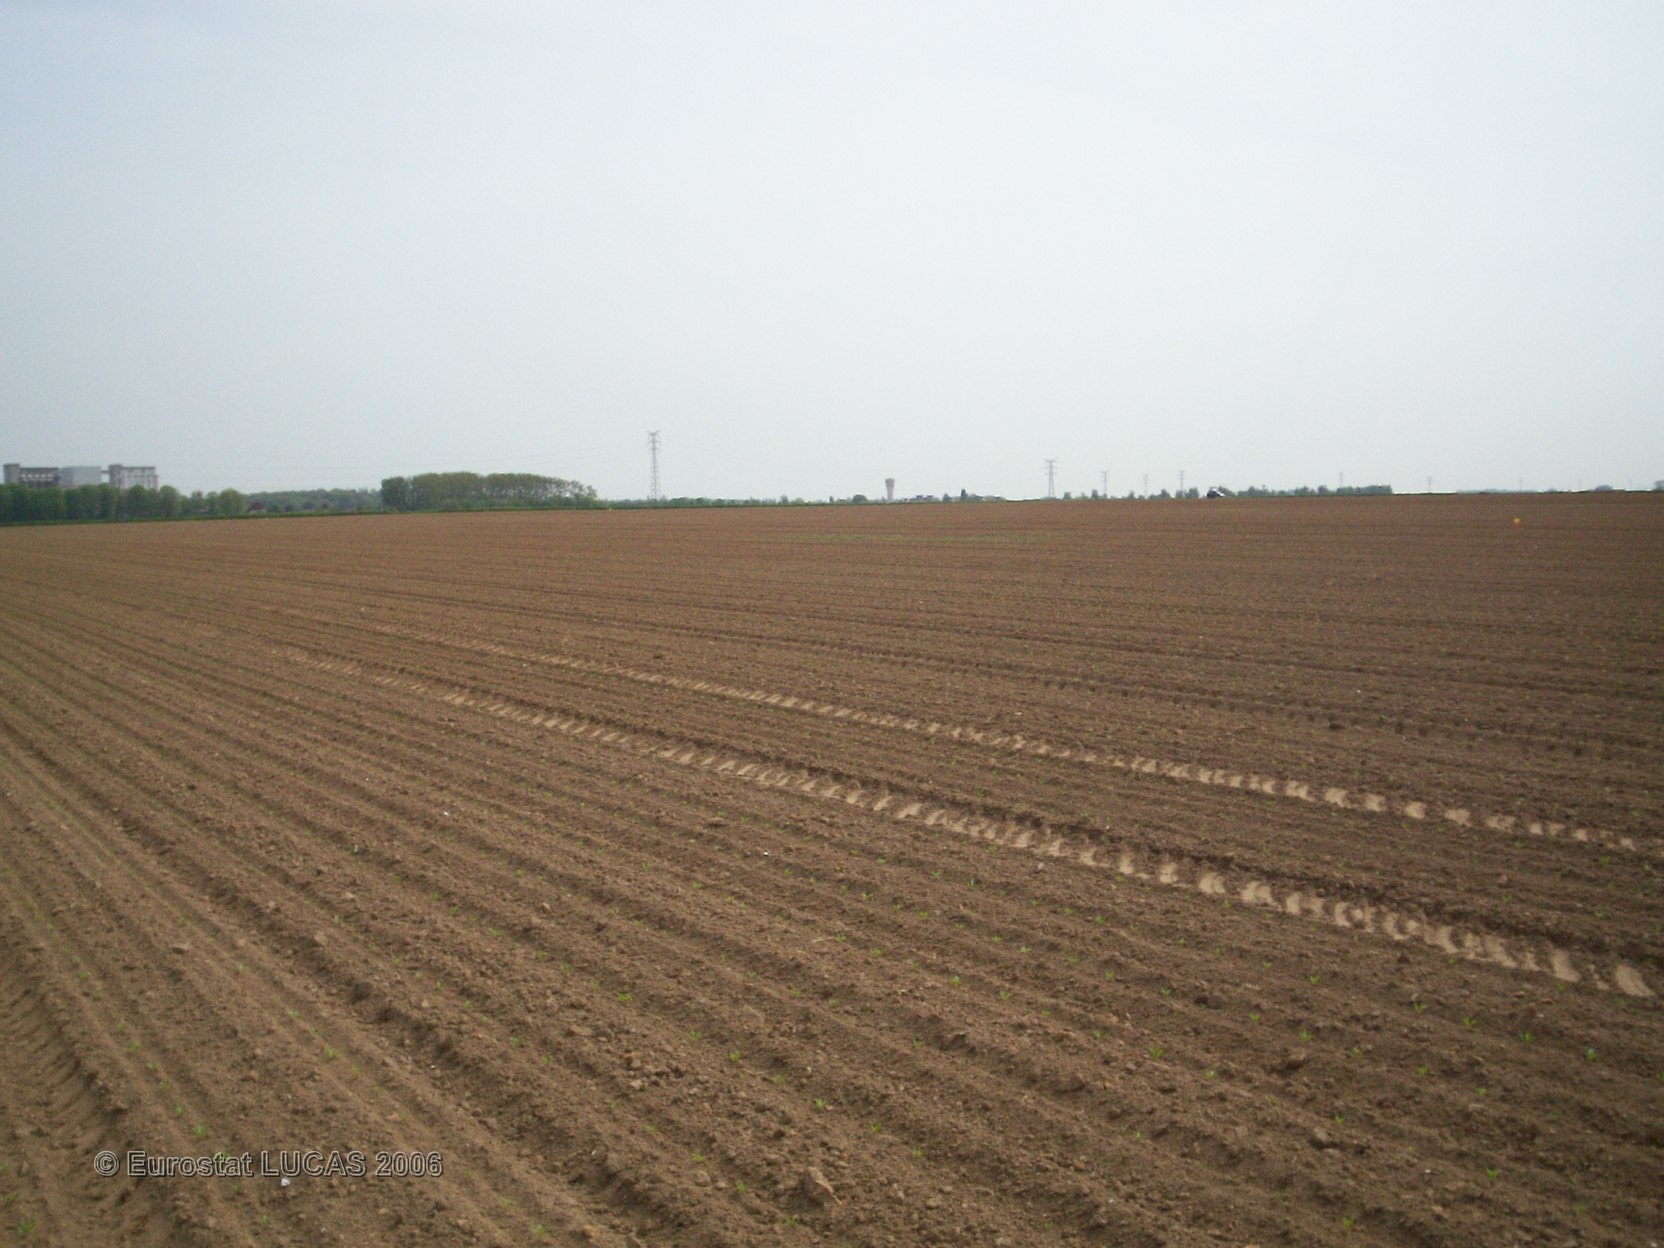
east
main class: Cropland
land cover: Sugar beet
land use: Agriculture (excluding fallow land and kitchen gardens)
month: May
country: FR
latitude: 48.6390
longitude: 2.8117
